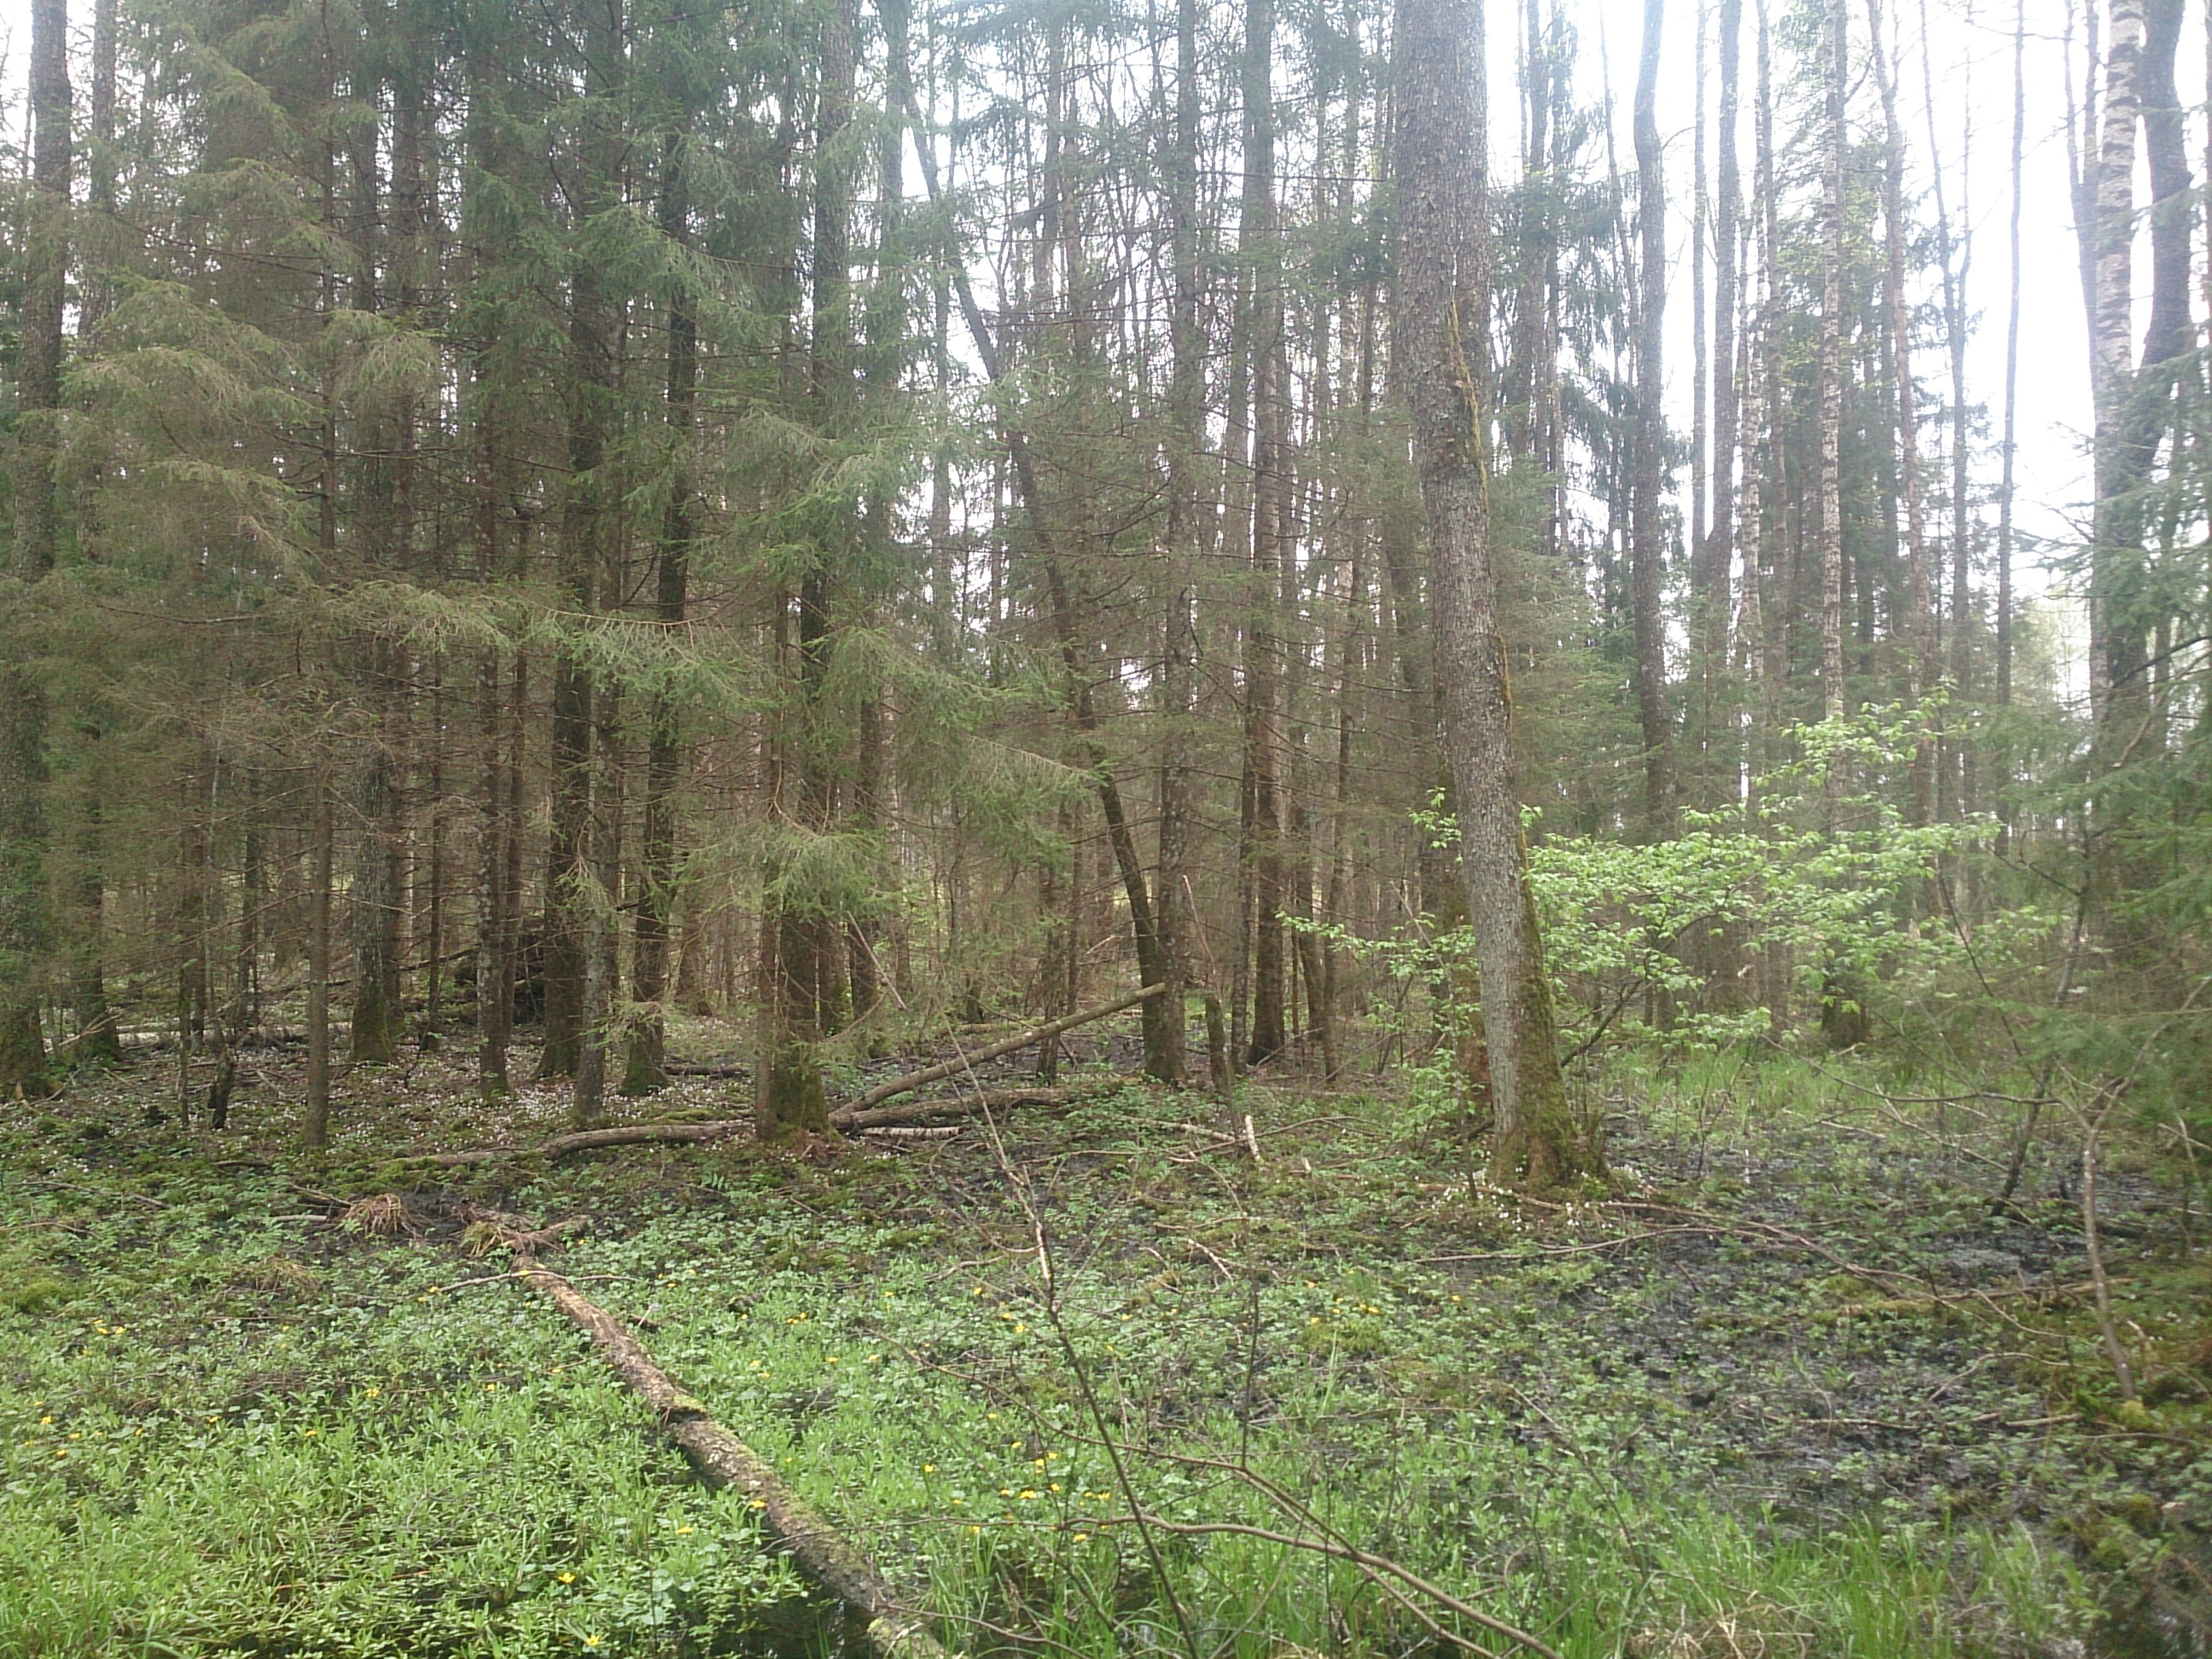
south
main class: Woodland
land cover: Spruce dominated mixed woodland
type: hemiboreal forest and nemoral coniferous forest and mixed broadleaved-coniferous forest
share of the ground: > 75 %
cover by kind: coniferous forest trees 50 %, broadleaved forest trees 50 %
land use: Forestry
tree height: > 5 m
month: May
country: LV
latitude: 56.7040
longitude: 24.2504
